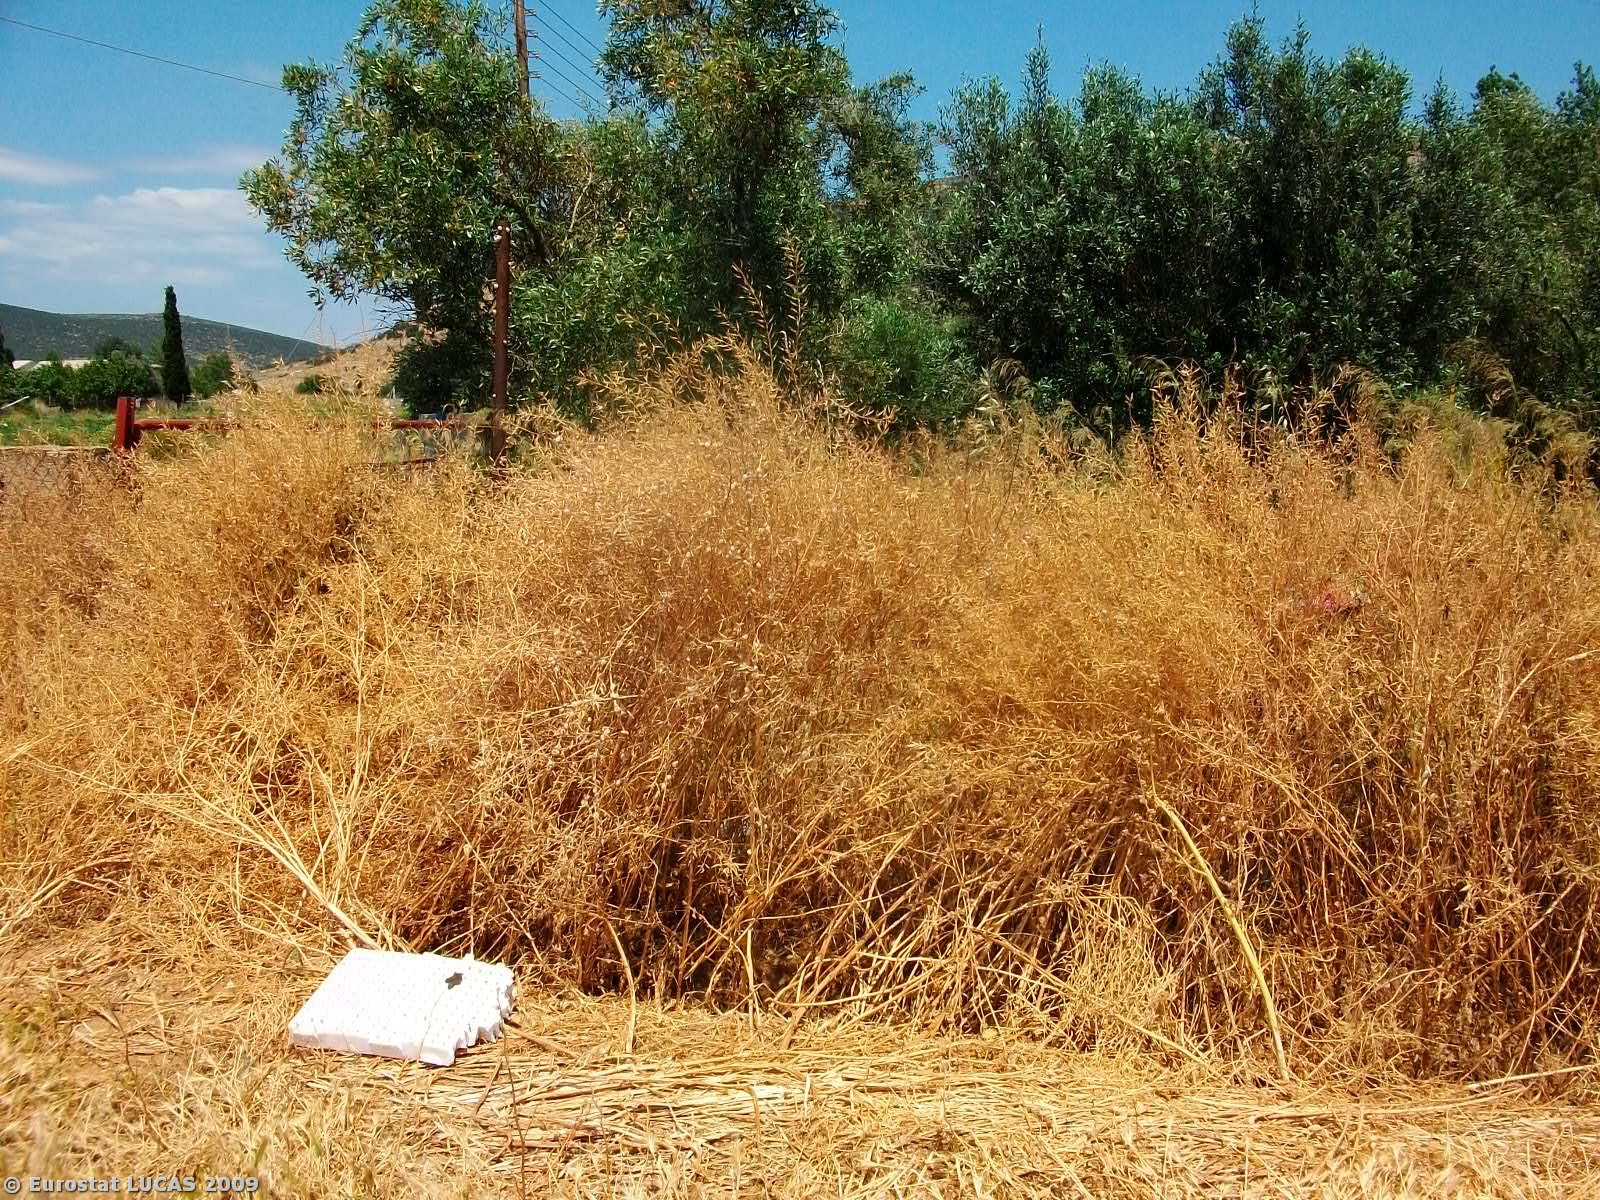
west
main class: Cropland
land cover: Other fresh vegetables
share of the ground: 50 - 75 %
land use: Agriculture (excluding fallow land and kitchen gardens)
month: May
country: GR
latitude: 38.1411
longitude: 23.9856
